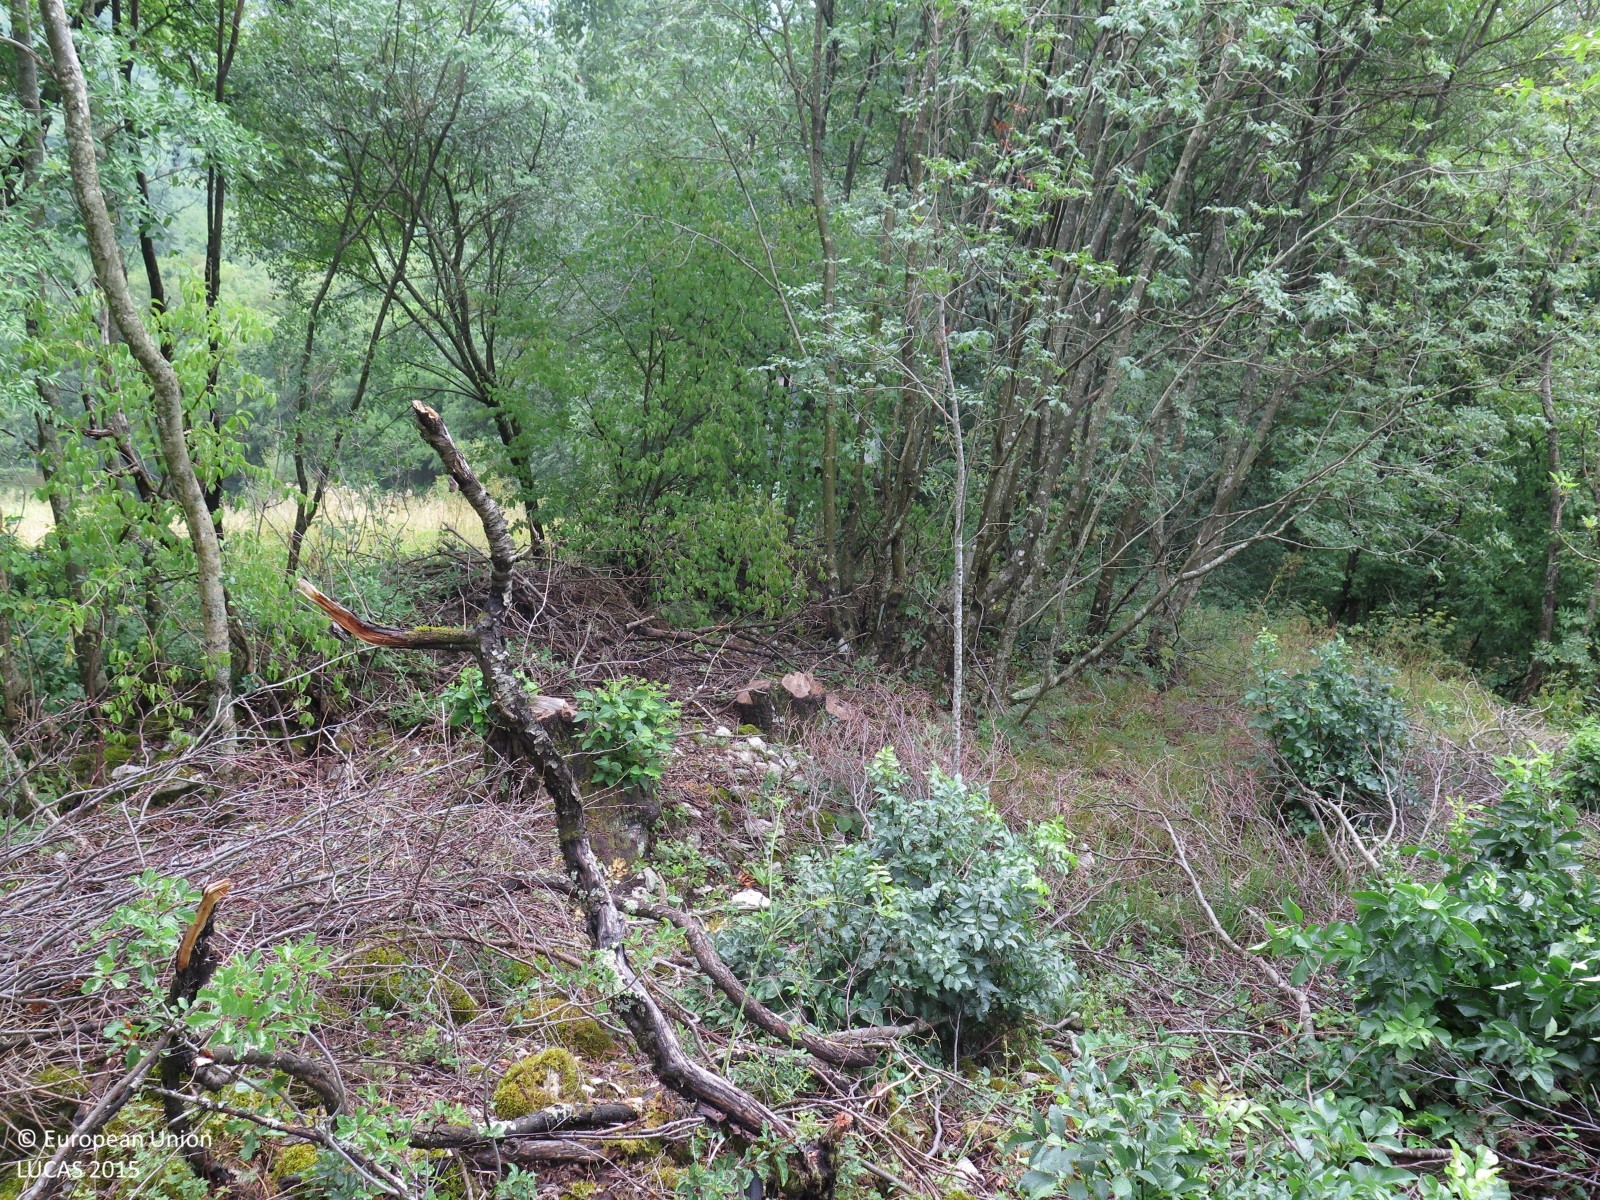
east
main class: Woodland
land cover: Broadleaved woodland
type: mesophytic deciduous forest
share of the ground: > 75 %
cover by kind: broadleaved forest trees 90 %, shrubs 5 %, herbaceous plants 5 %
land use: Semi-natural and natural areas not in use
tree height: < 5 m
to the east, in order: Broadleaved woodland; Dry stone walls; Broadleaved woodland
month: July
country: HR
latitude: 45.4059
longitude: 14.1219
